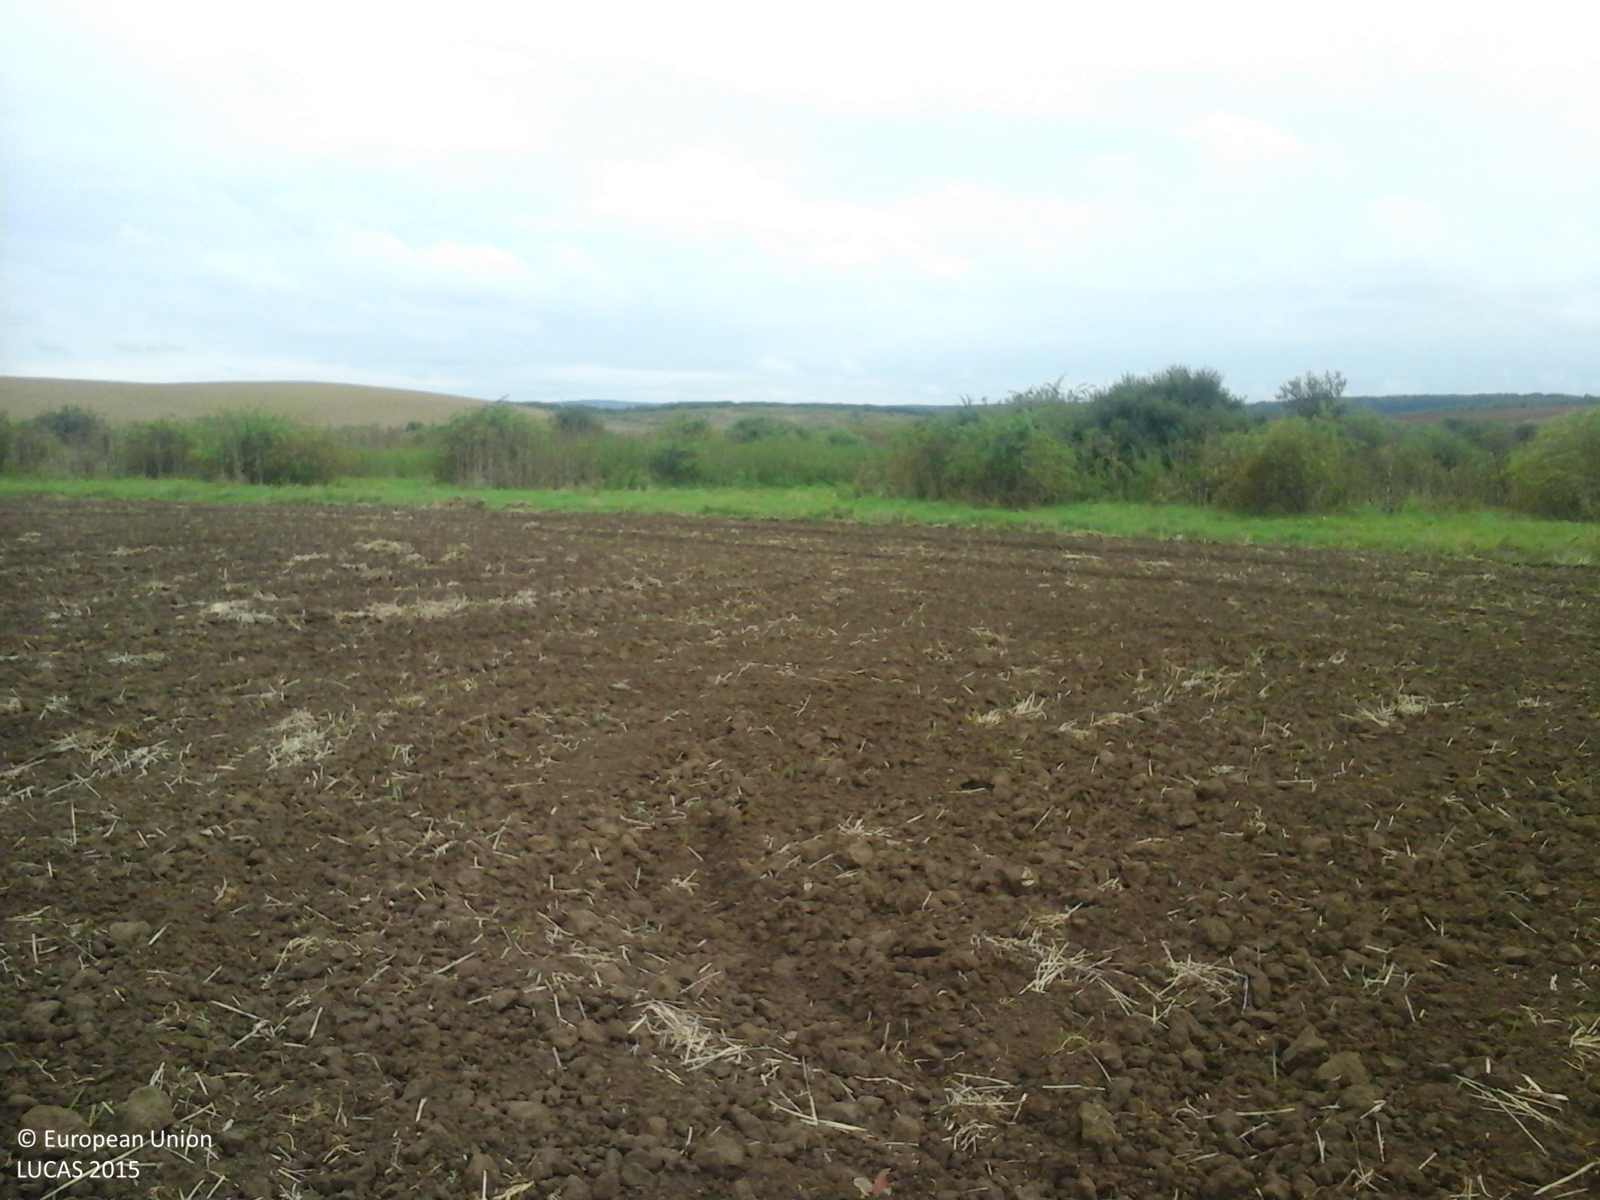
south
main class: Cropland
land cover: Common wheat
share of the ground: < 10 %
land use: Agriculture (excluding fallow land and kitchen gardens)
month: September
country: RO
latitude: 47.1962
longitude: 22.0470
